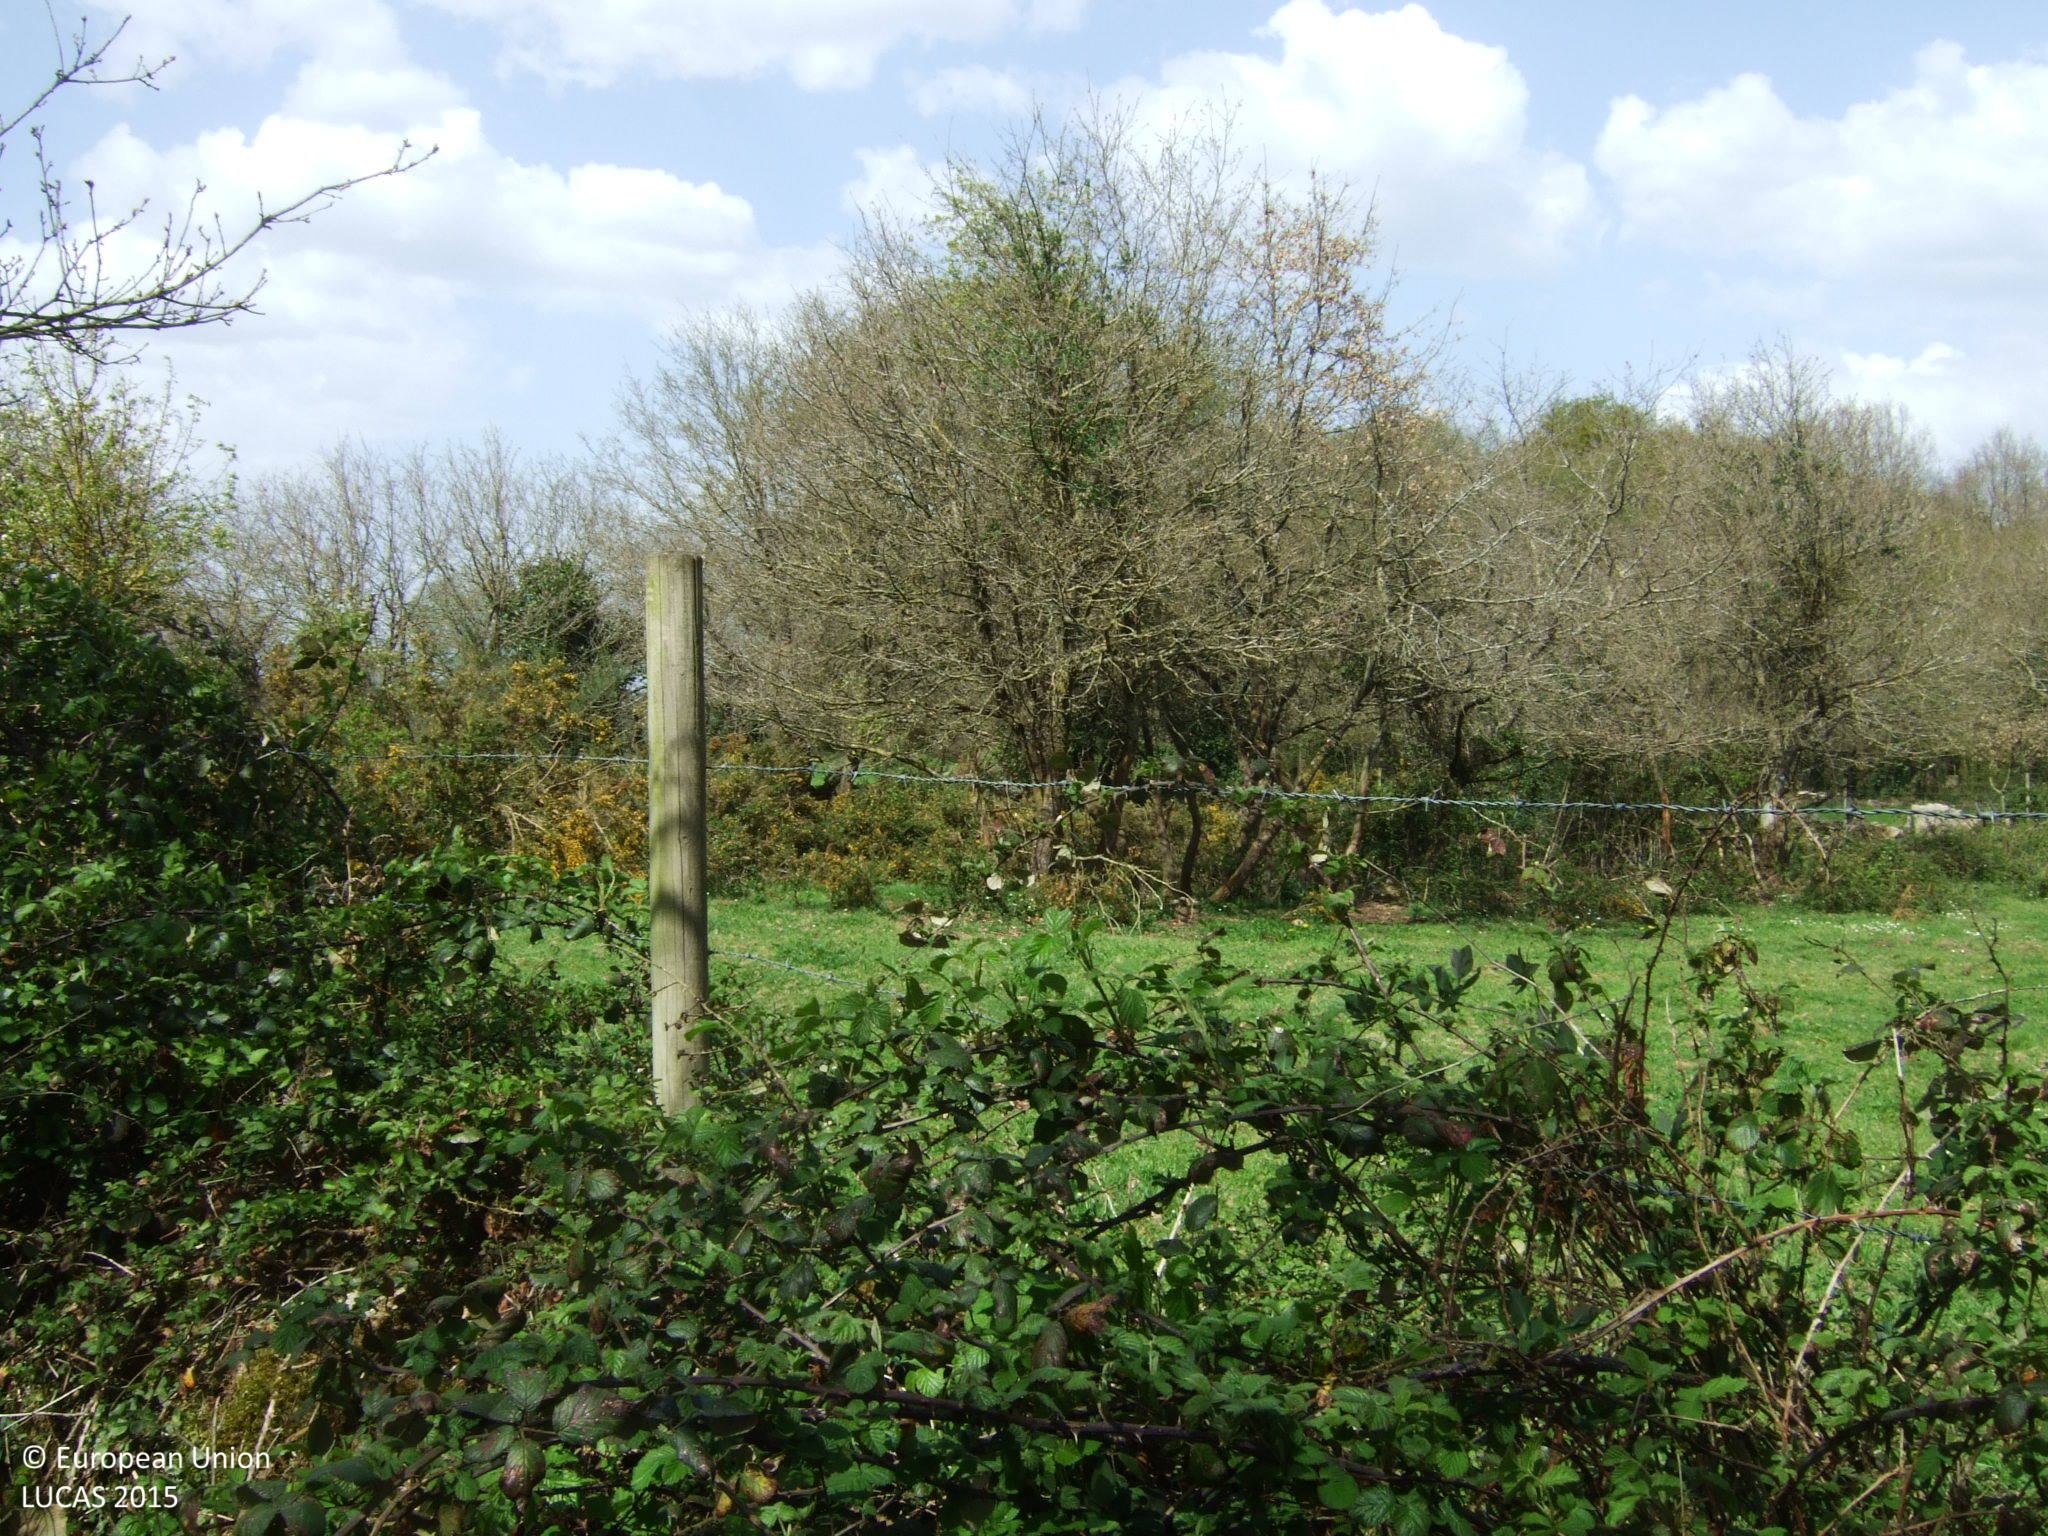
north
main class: Grassland
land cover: Grassland without tree/shrub cover
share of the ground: > 75 %
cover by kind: herbaceous plants 100 %
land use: Agriculture (excluding fallow land and kitchen gardens)
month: April
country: ES
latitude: 42.9705
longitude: -7.6491
